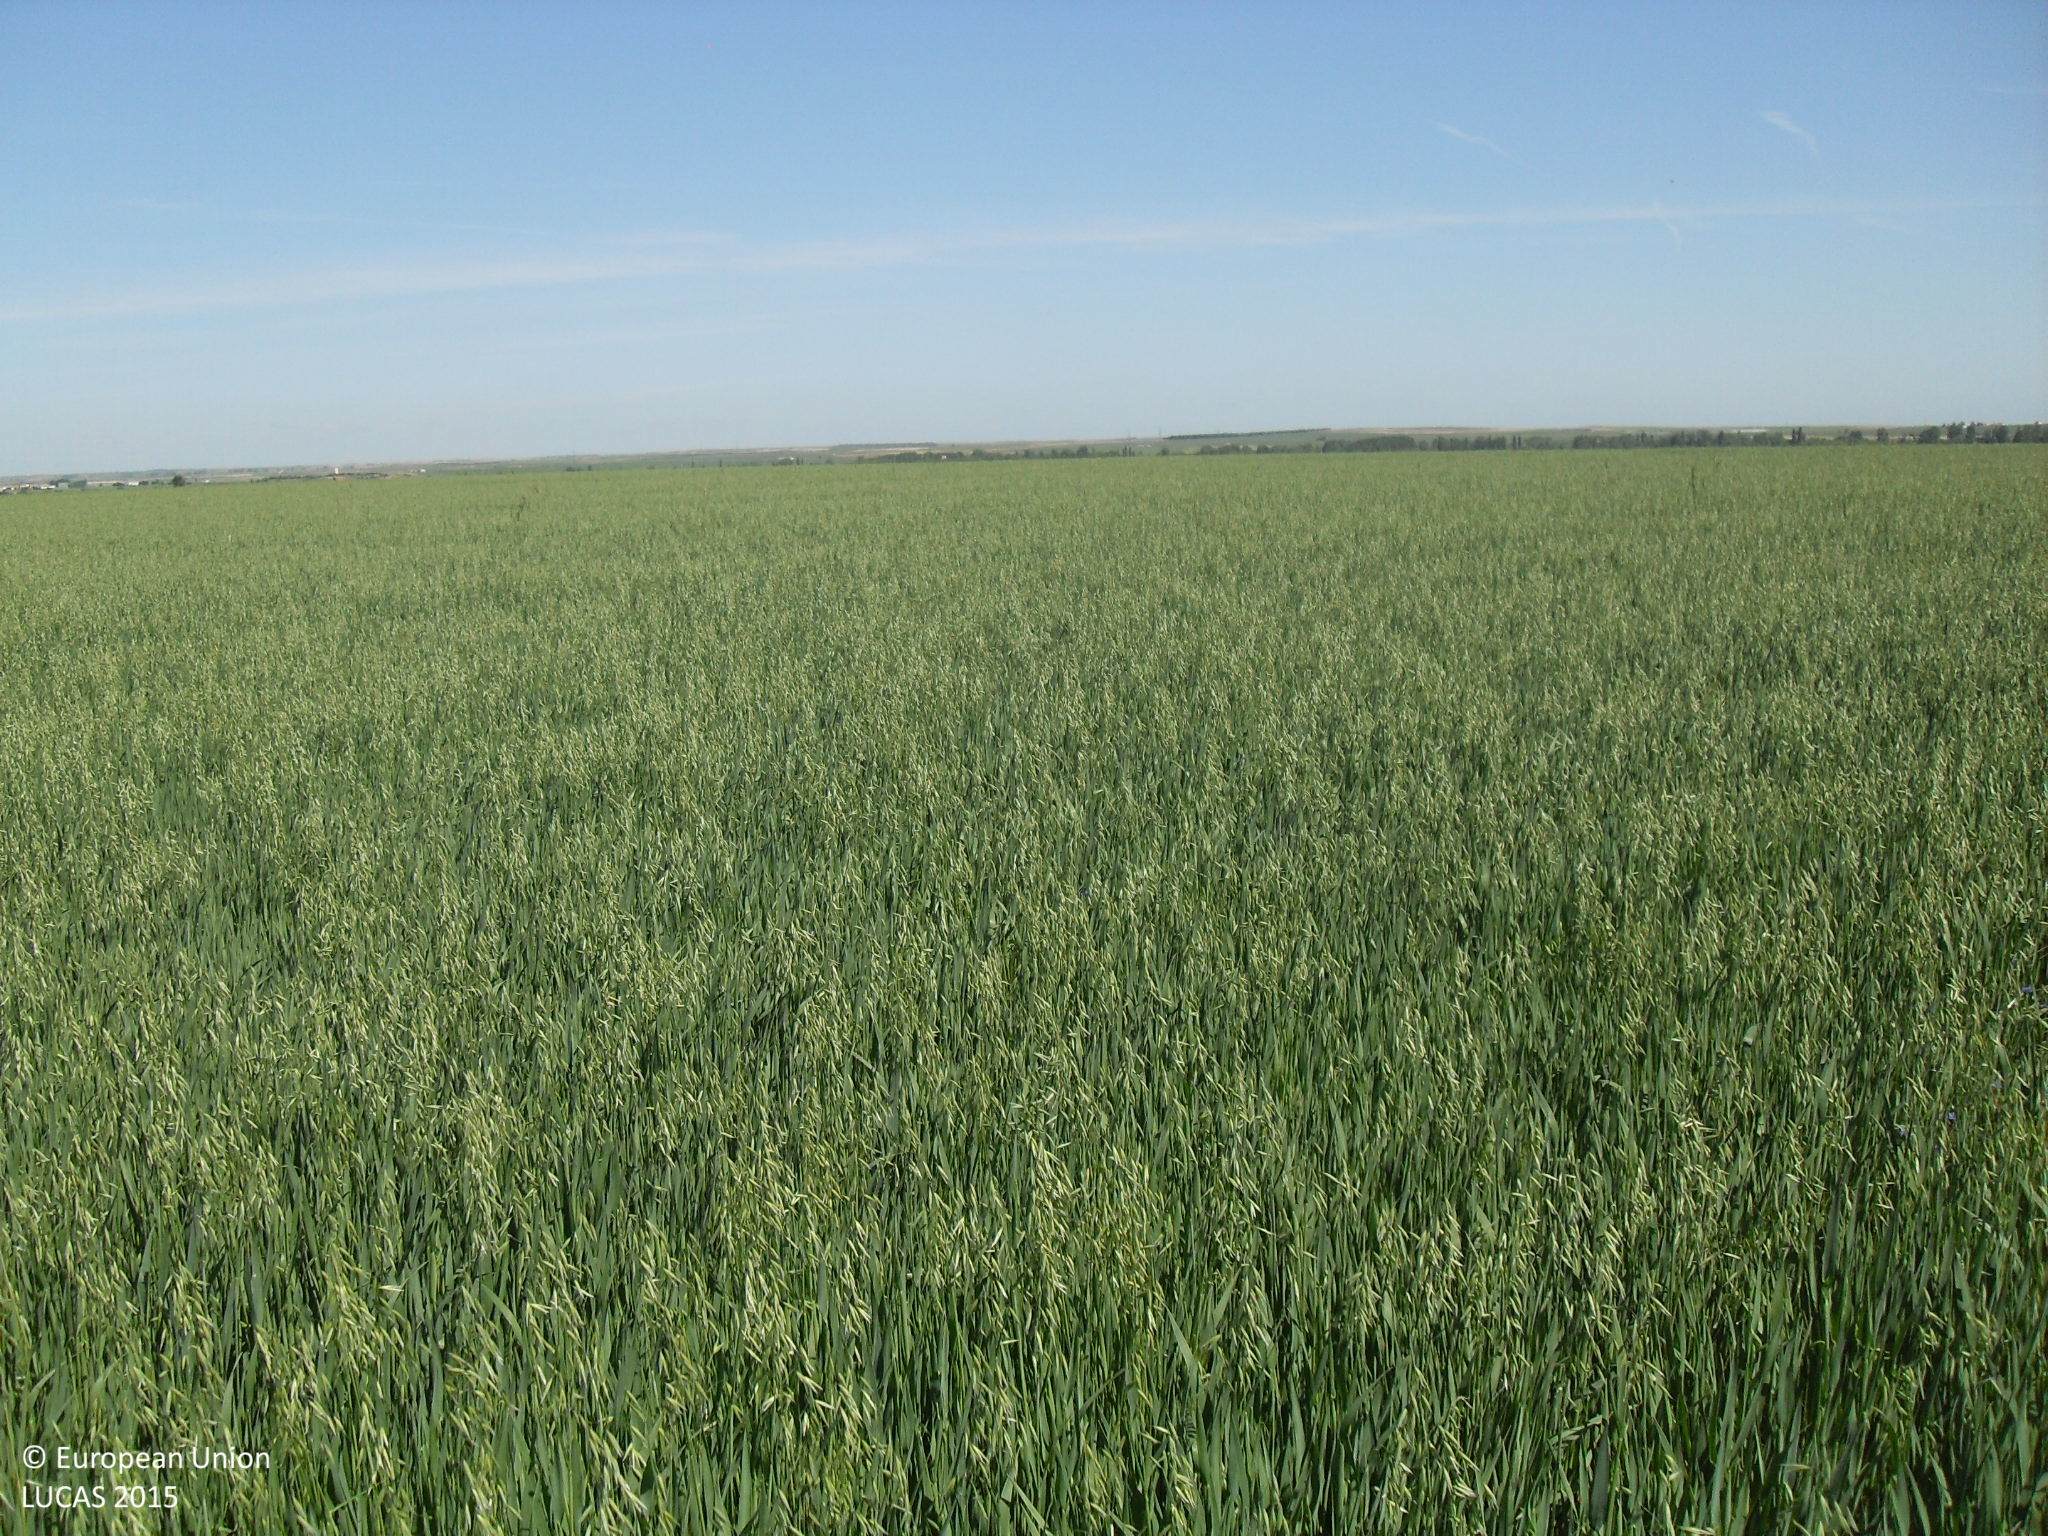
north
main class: Cropland
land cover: Oats
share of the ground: > 75 %
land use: Agriculture (excluding fallow land and kitchen gardens)
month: May
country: ES
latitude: 40.8929
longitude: -5.3217
